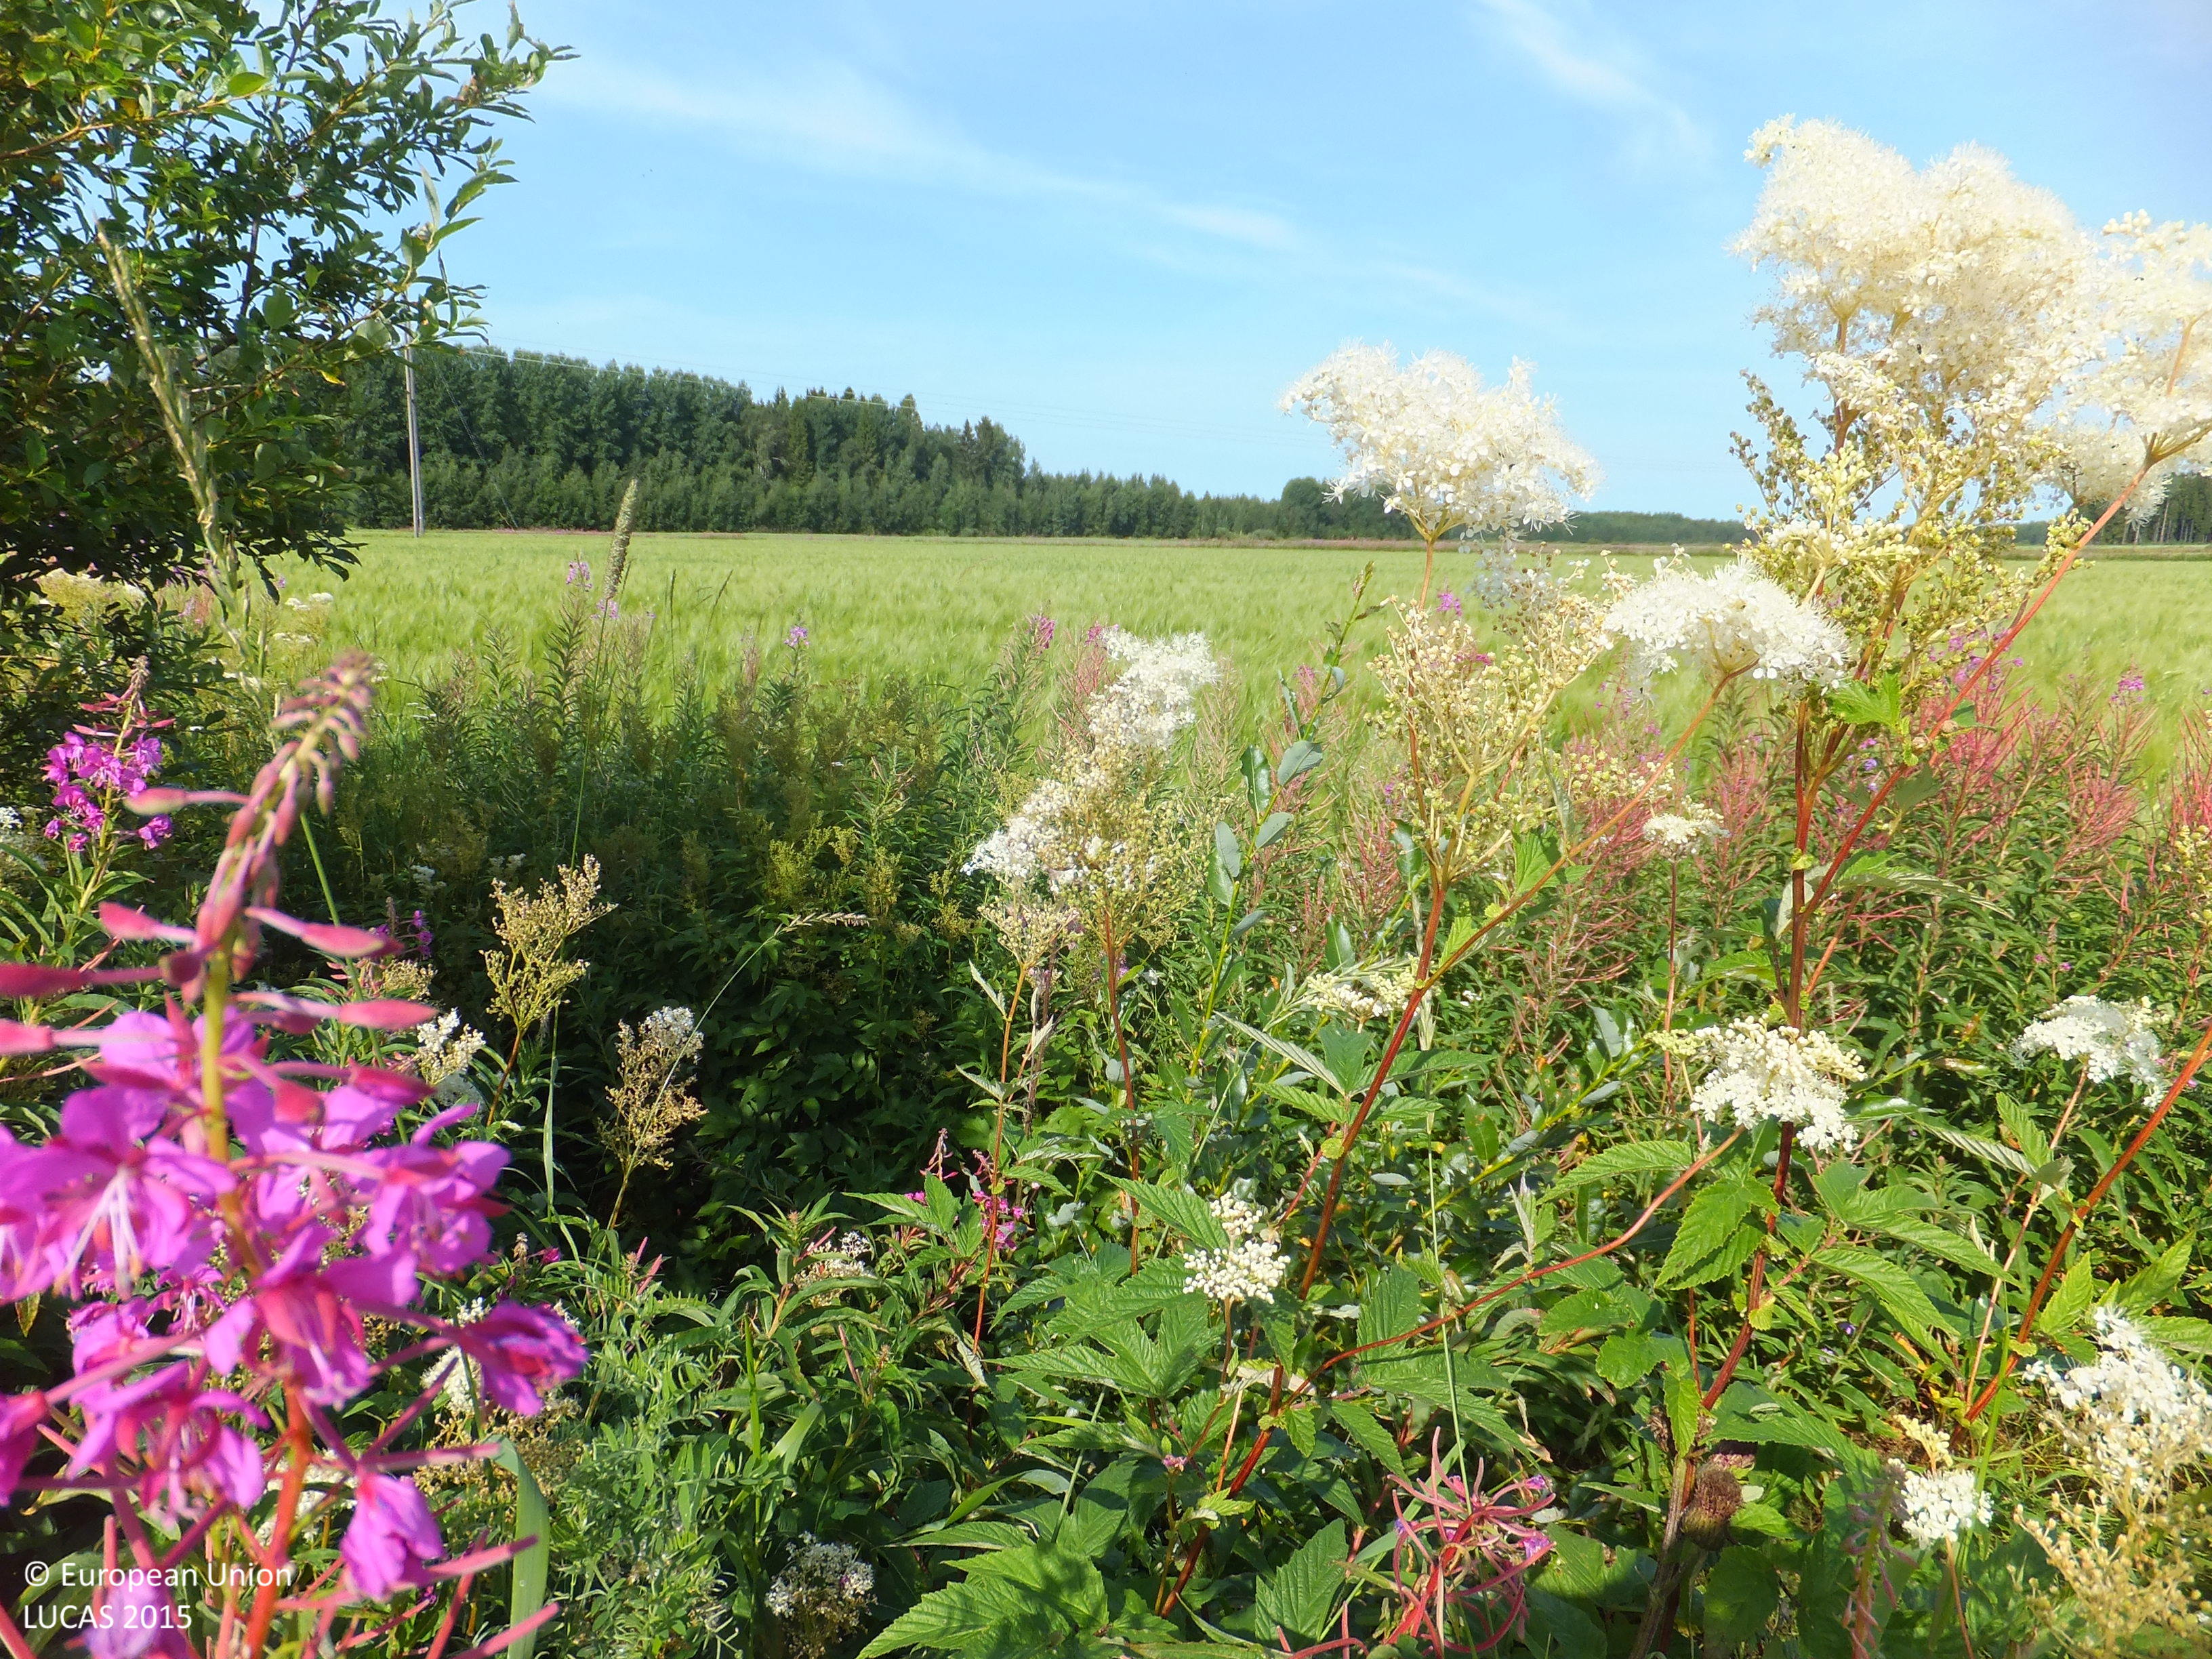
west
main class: Cropland
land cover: Oats
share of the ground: 50 - 75 %
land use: Agriculture (excluding fallow land and kitchen gardens)
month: August
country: FI
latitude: 63.3165
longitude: 22.9290
